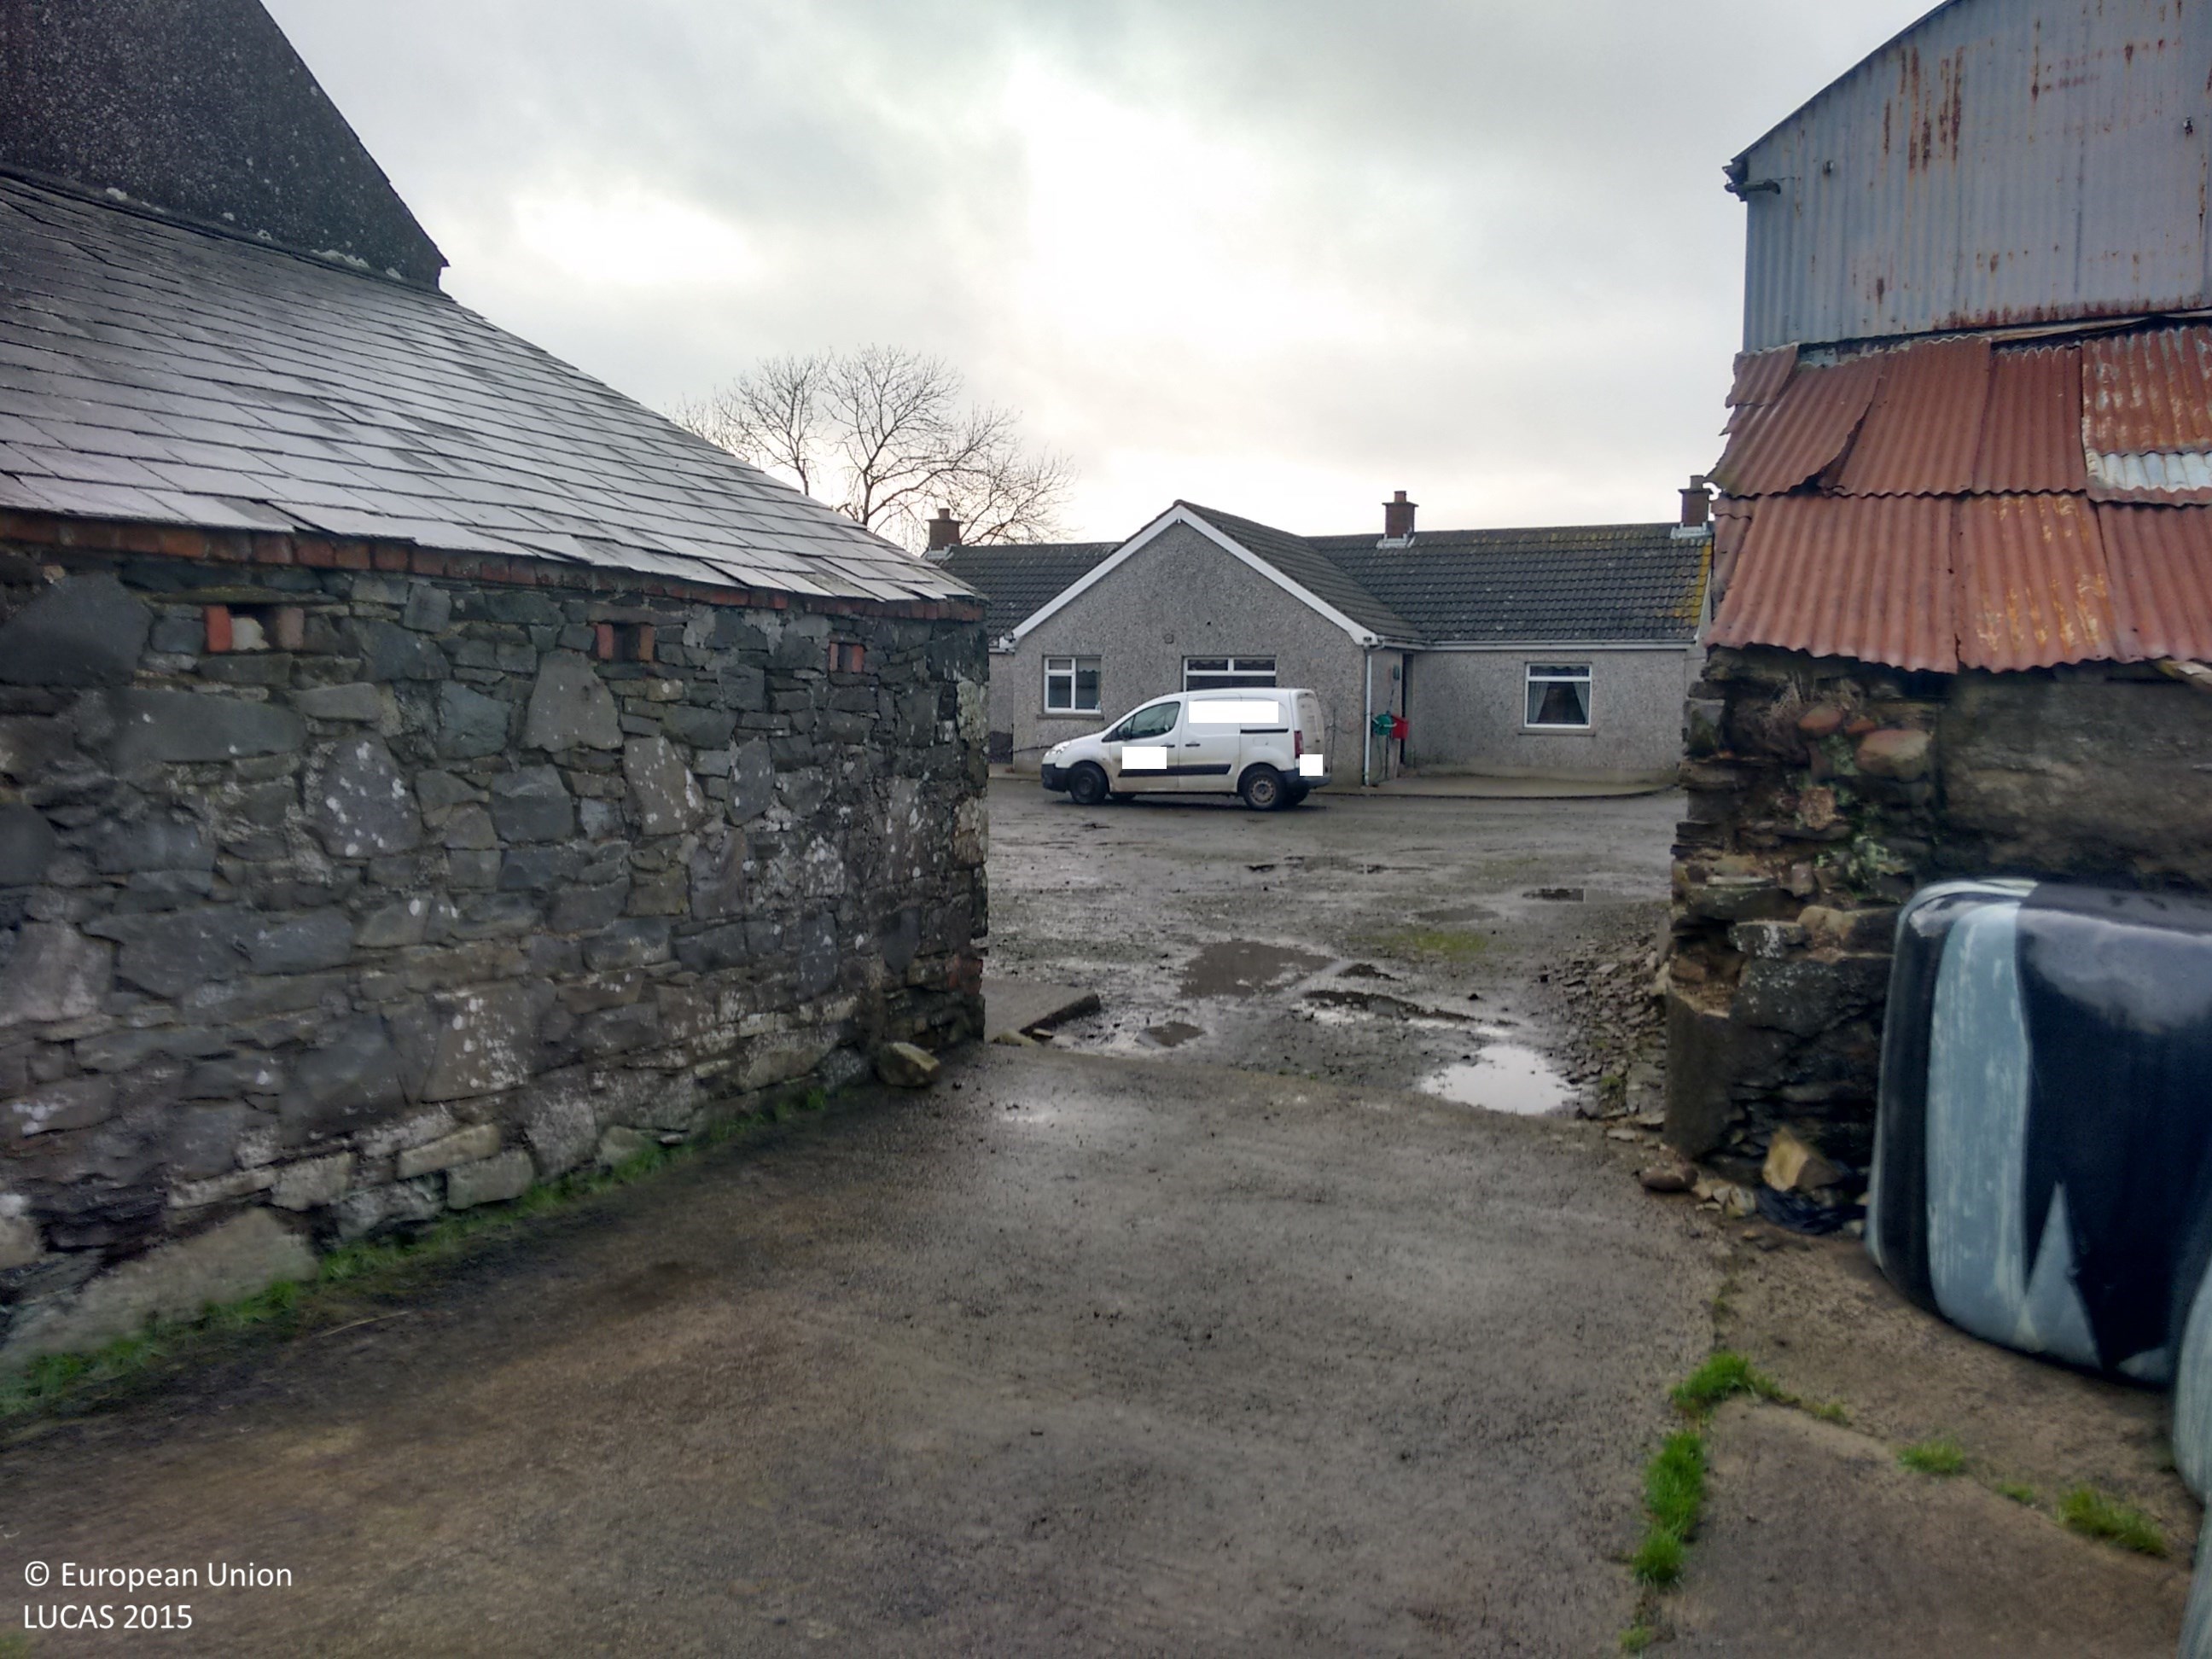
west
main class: Grassland
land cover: Grassland without tree/shrub cover
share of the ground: > 75 %
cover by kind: herbaceous plants 100 %
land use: Agriculture (excluding fallow land and kitchen gardens)
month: November
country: GB
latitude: 54.4872
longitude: -5.7718
